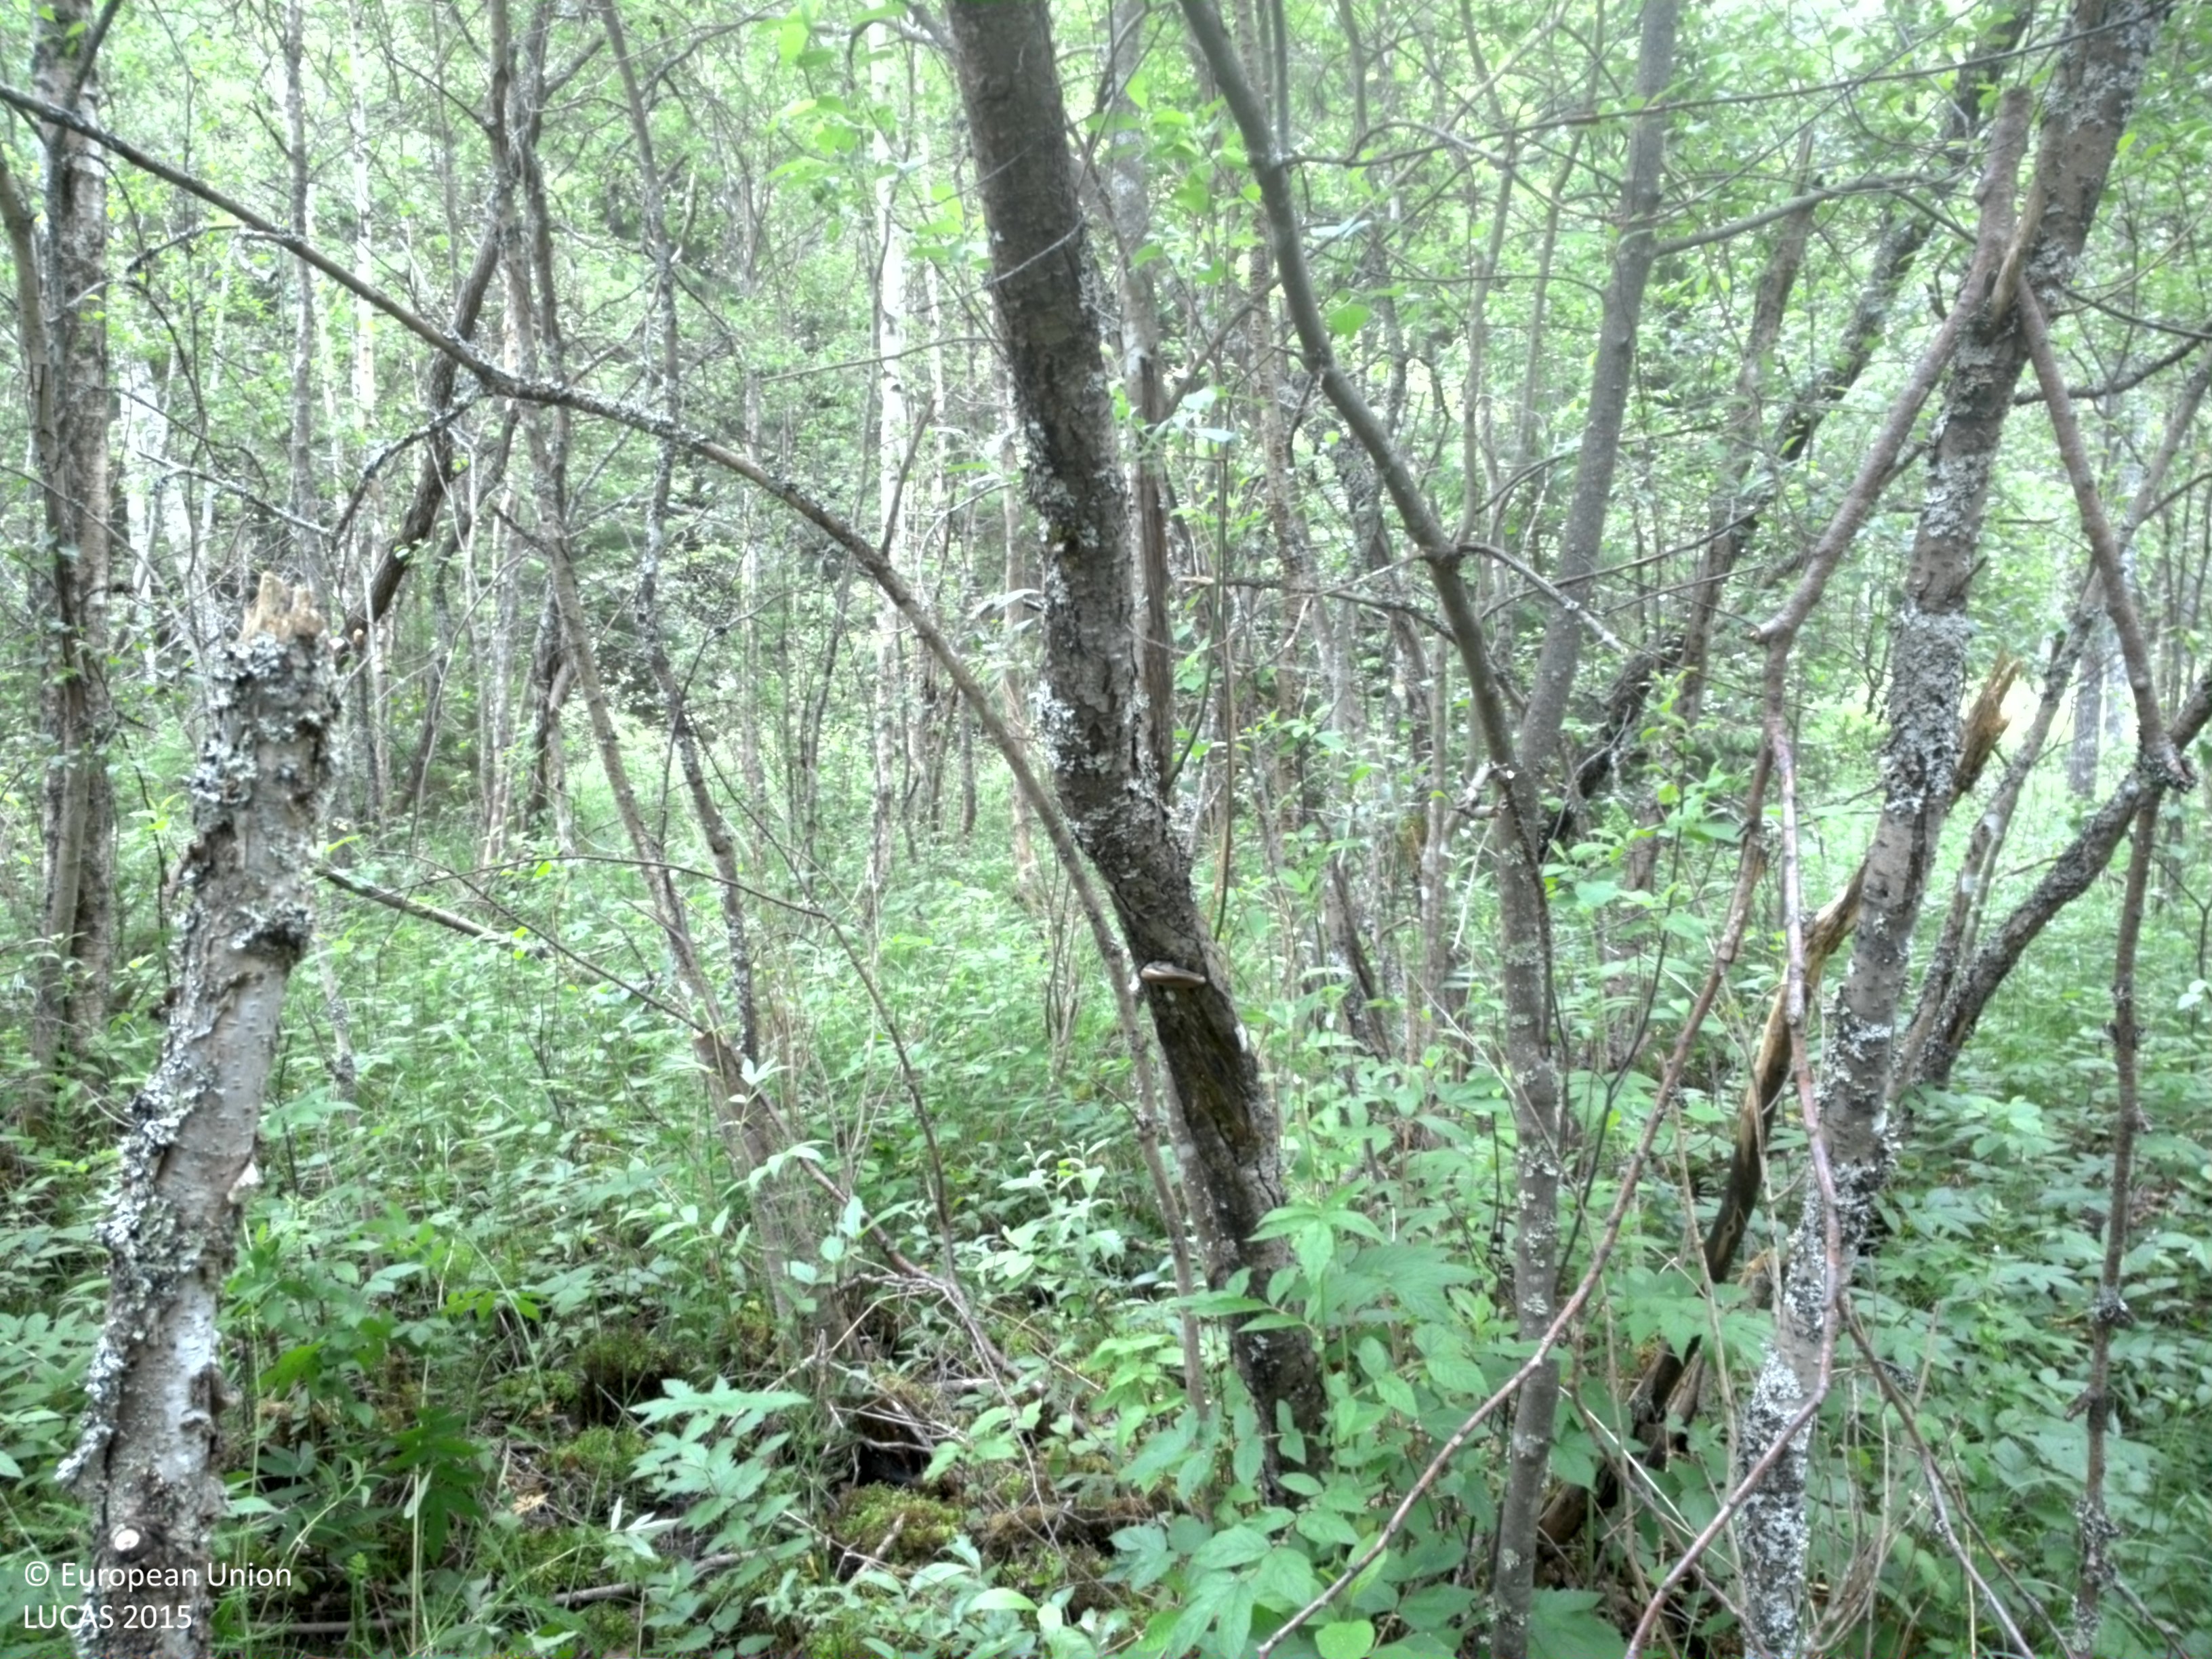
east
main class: Woodland
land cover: Broadleaved woodland
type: hemiboreal forest and nemoral coniferous forest and mixed broadleaved-coniferous forest
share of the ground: > 75 %
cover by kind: broadleaved forest trees 90 %, herbaceous plants 10 %
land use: Forestry
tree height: > 5 m
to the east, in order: Broadleaved woodland; Spruce dominated coniferous woodland; Other coniferous woodland; Tracks; Other coniferous woodland; Spruce dominated coniferous woodland; Rivers and streams; Other coniferous woodland; Spruce dominated coniferous woodland
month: July
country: SE
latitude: 59.9547
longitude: 16.9571
